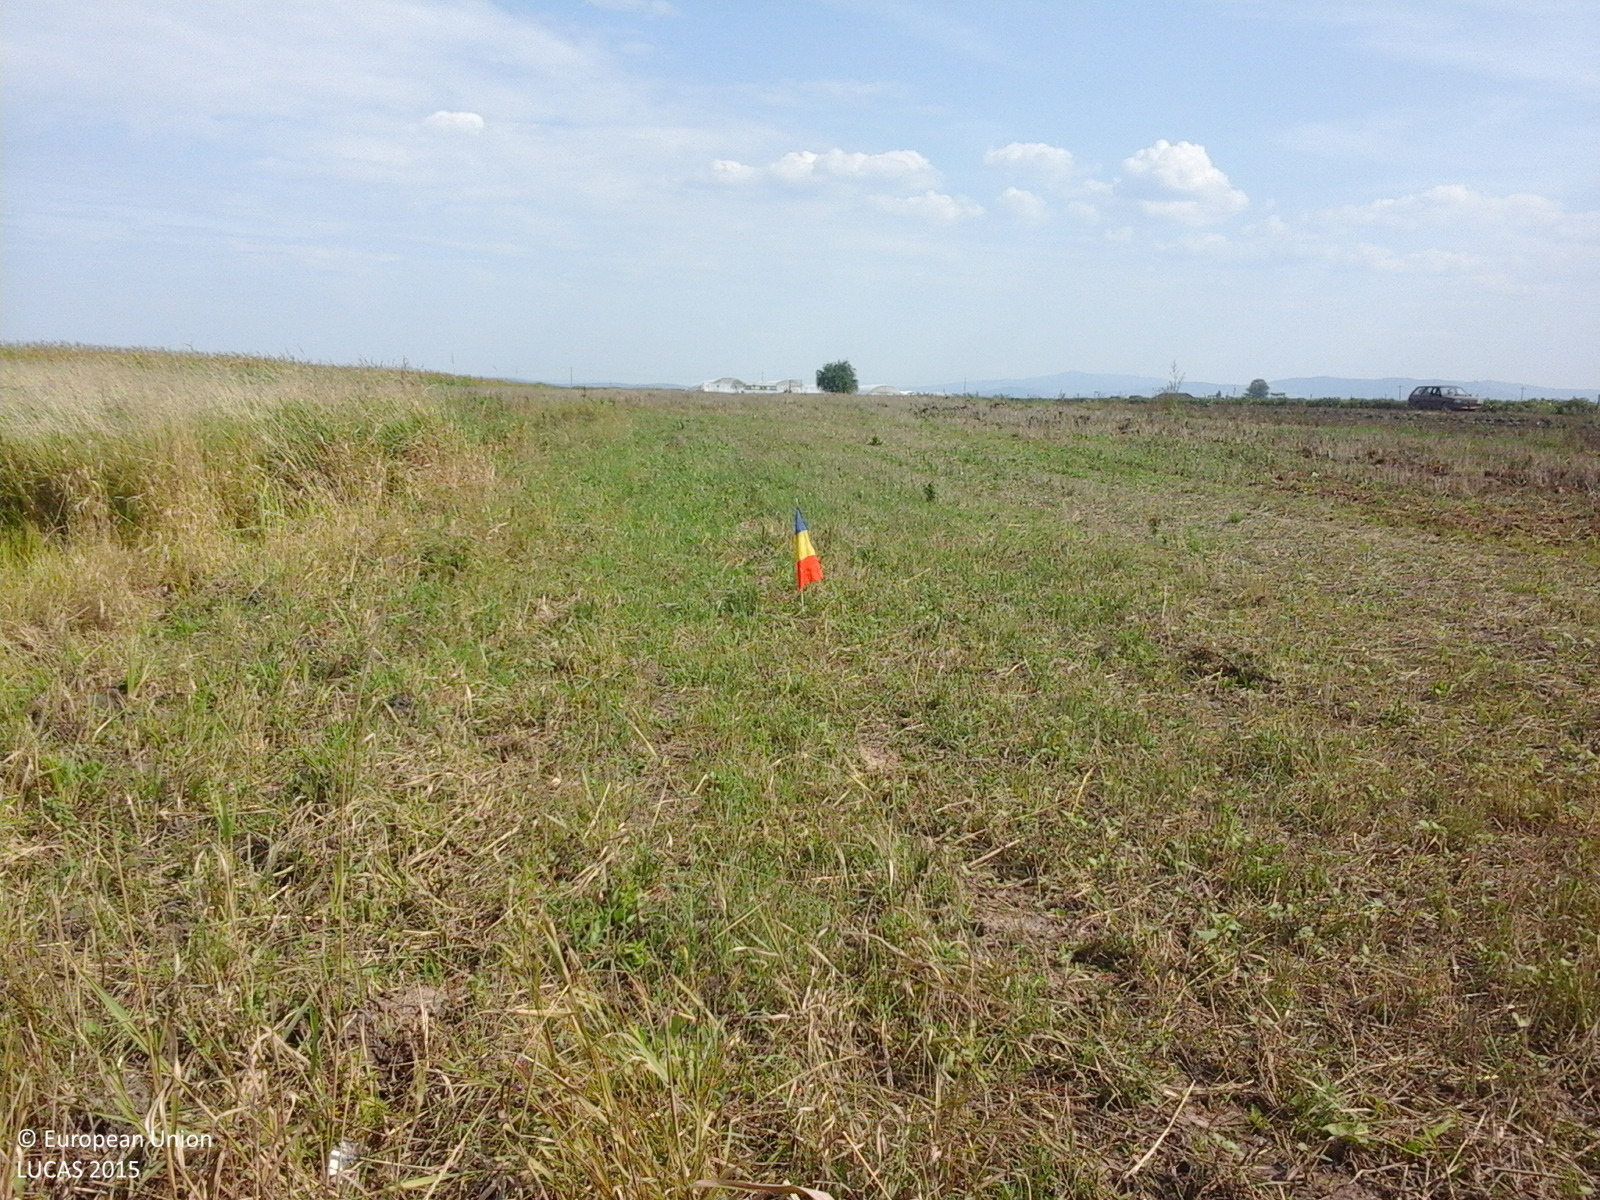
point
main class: Cropland
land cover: Common wheat
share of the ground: < 10 %
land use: Agriculture (excluding fallow land and kitchen gardens)
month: August
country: RO
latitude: 46.3964
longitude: 21.5478
